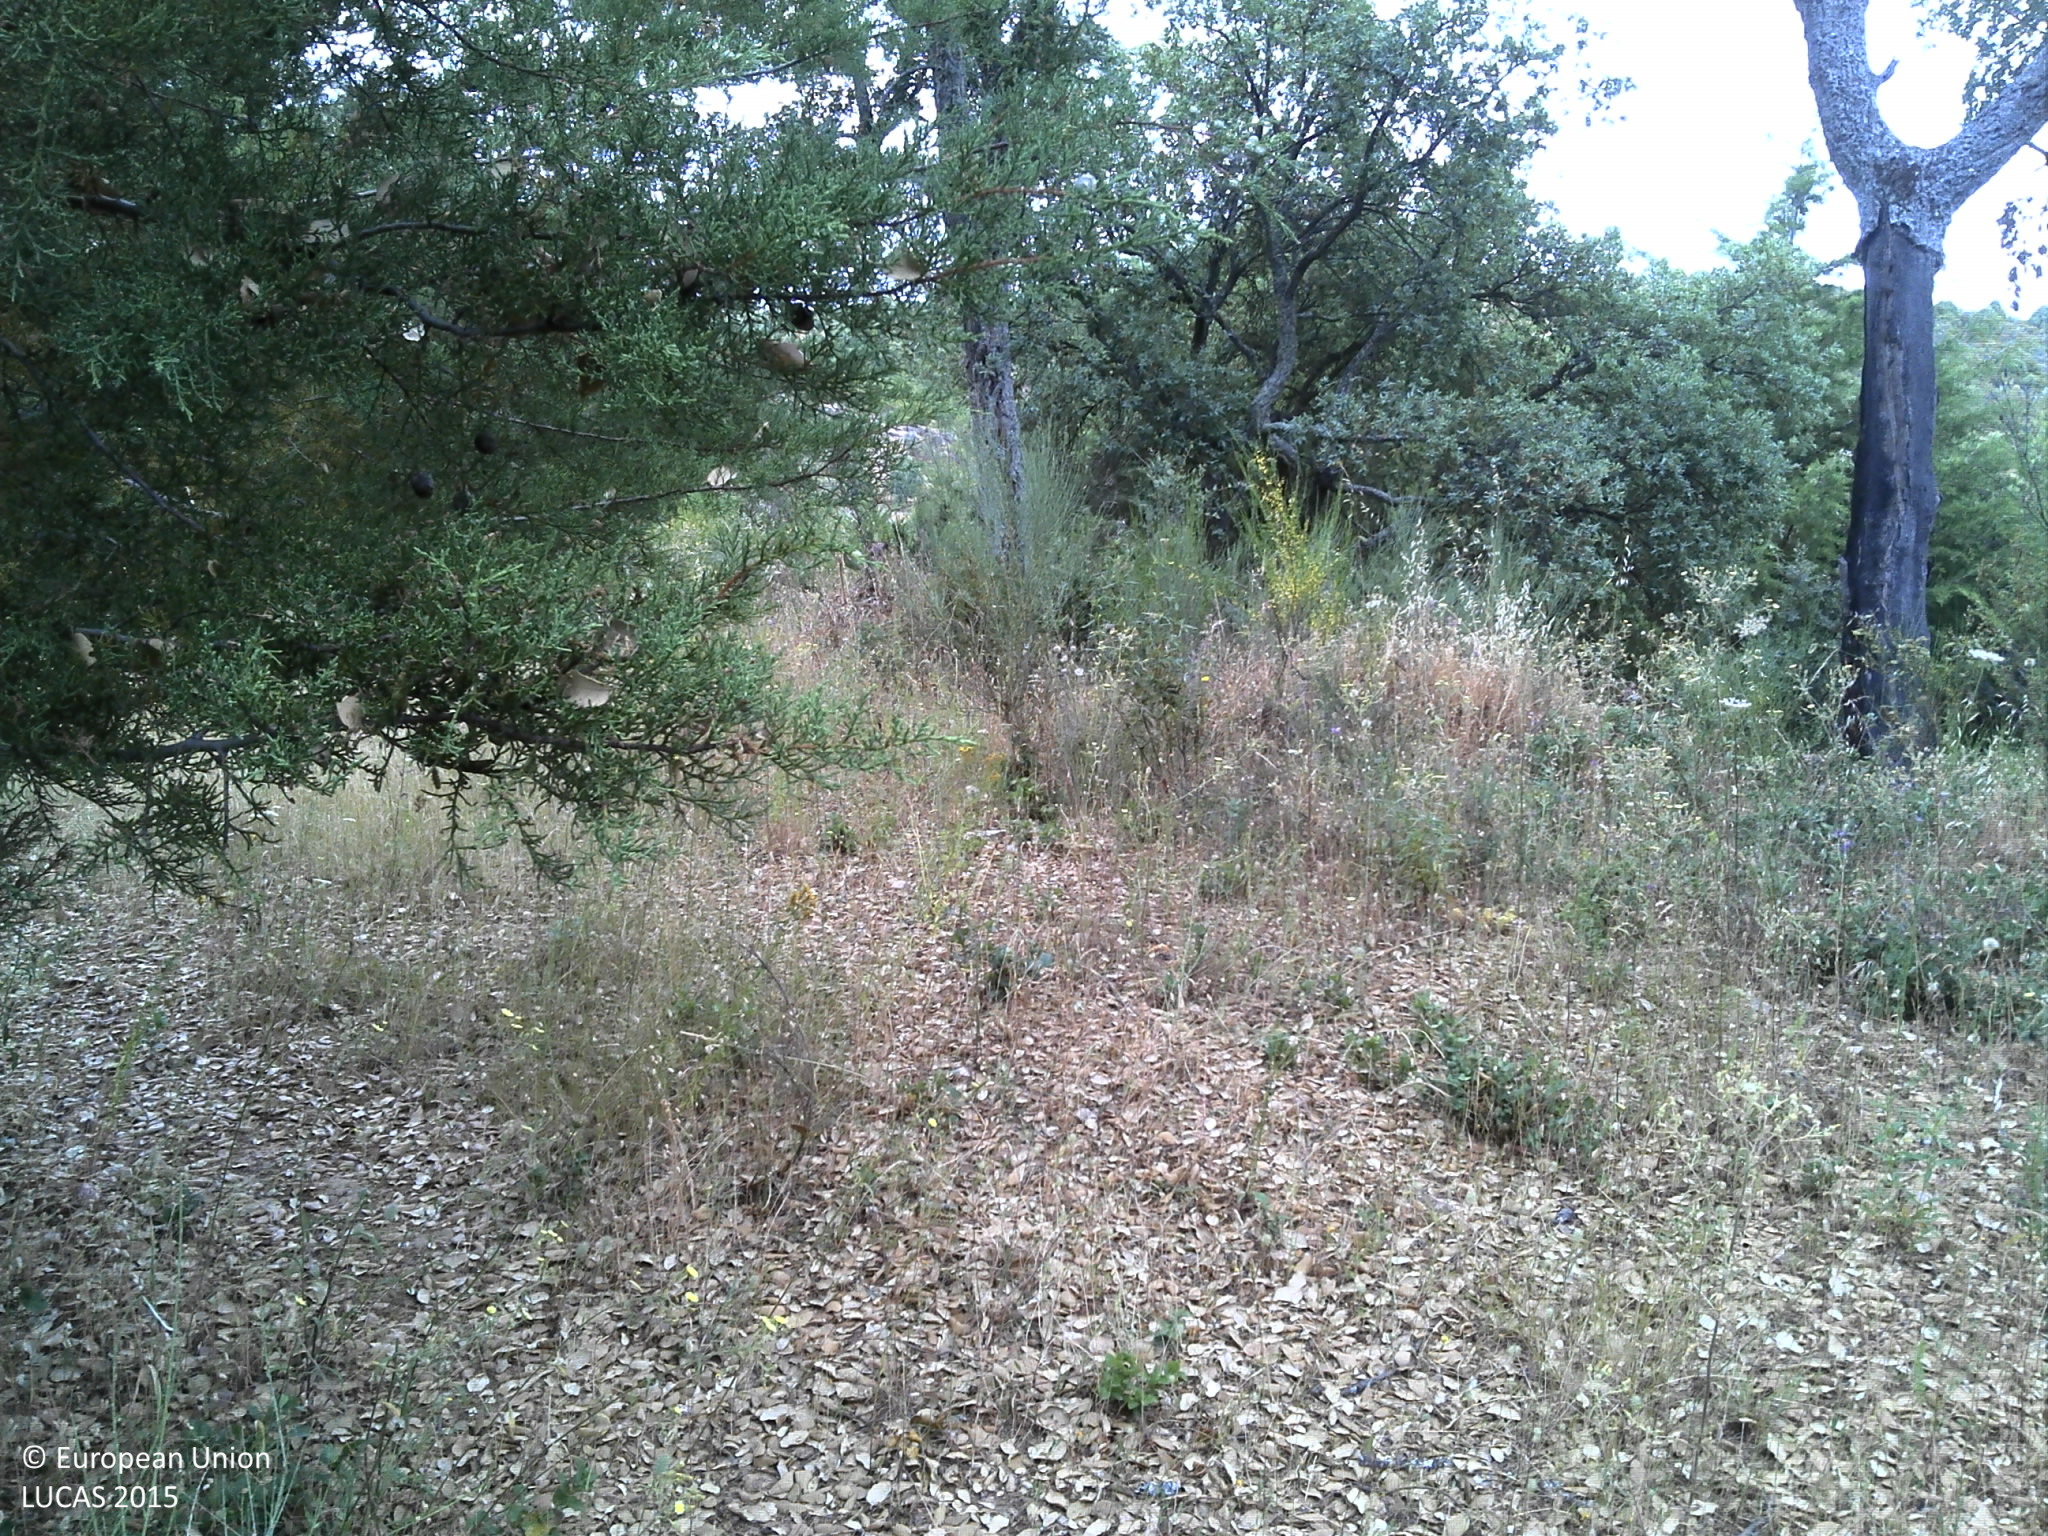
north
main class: Woodland
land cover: Other coniferous woodland
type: coniferous forest of the mediterranean region
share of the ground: < 10 %
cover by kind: shrubs 45 %, herbaceous plants 45 %, coniferous forest trees 10 %
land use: Forestry
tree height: > 5 m
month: June
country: PT
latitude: 41.2990
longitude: -6.9861
